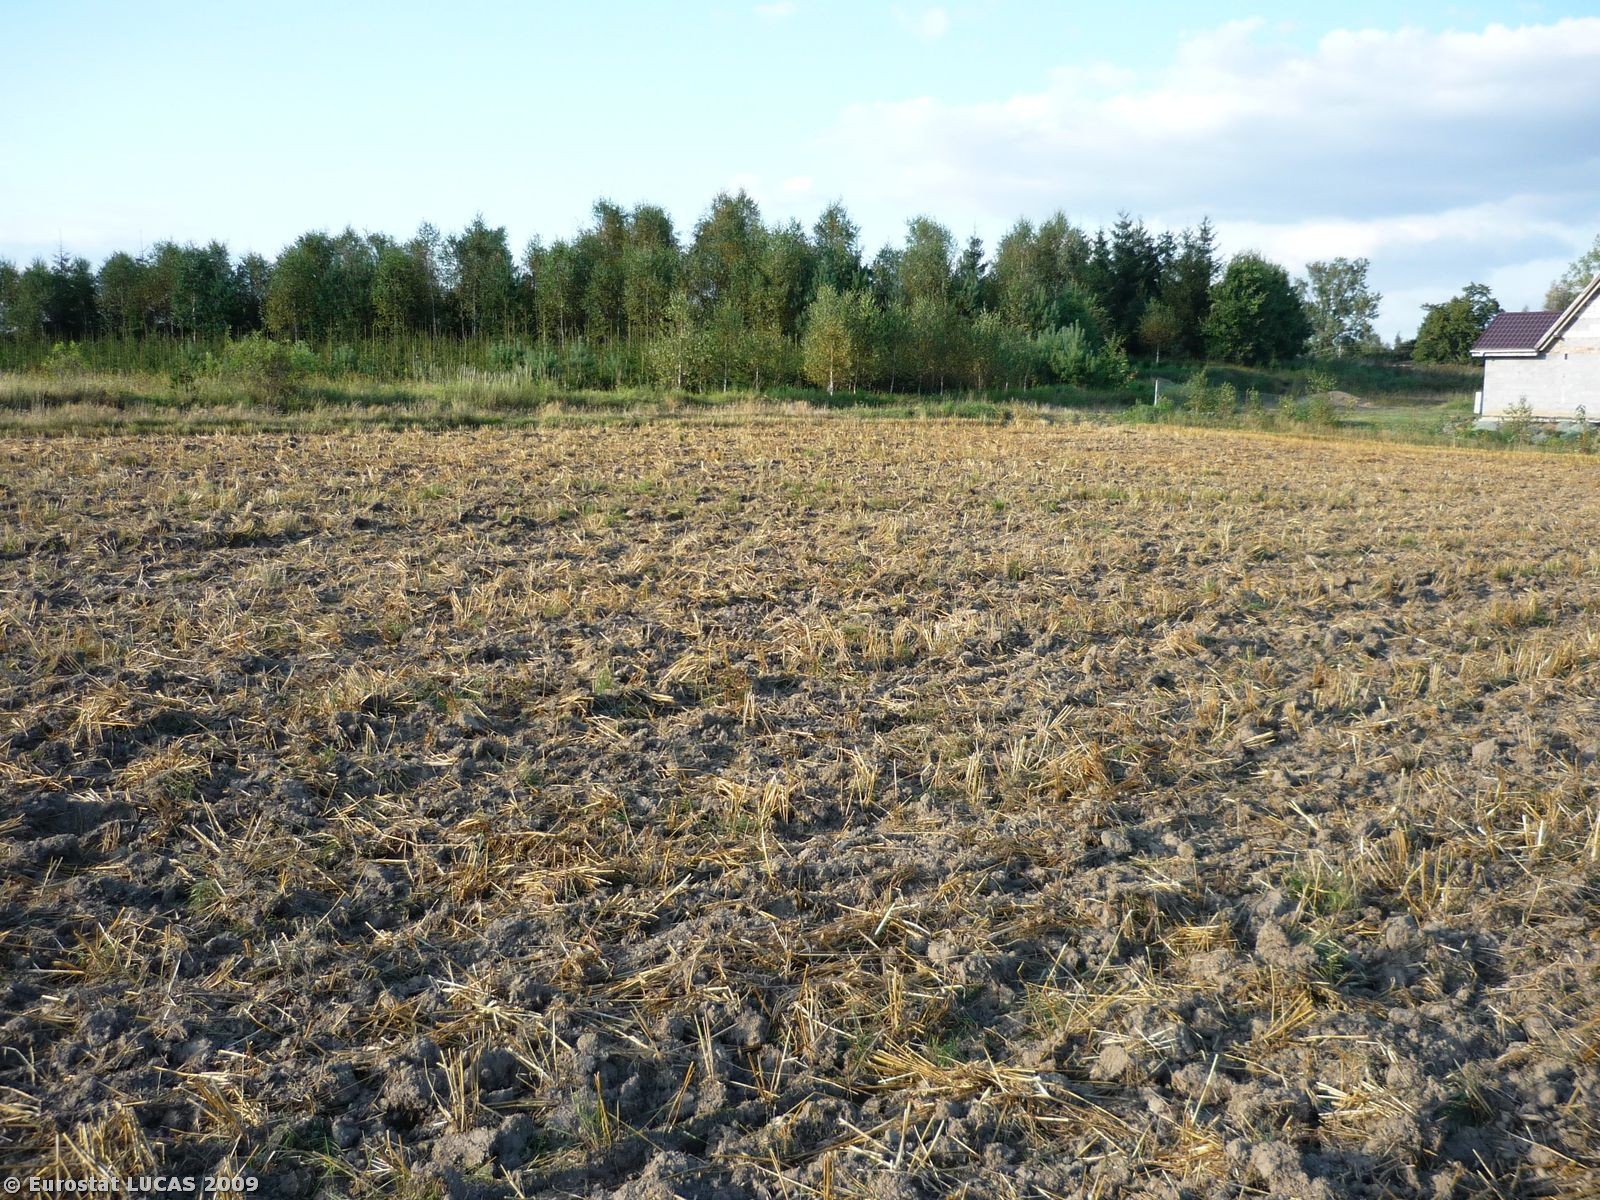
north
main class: Cropland
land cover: Oats
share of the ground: < 10 %
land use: Agriculture (excluding fallow land and kitchen gardens)
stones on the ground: 10 - 25 %
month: September
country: PL
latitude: 50.8534
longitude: 16.0431
